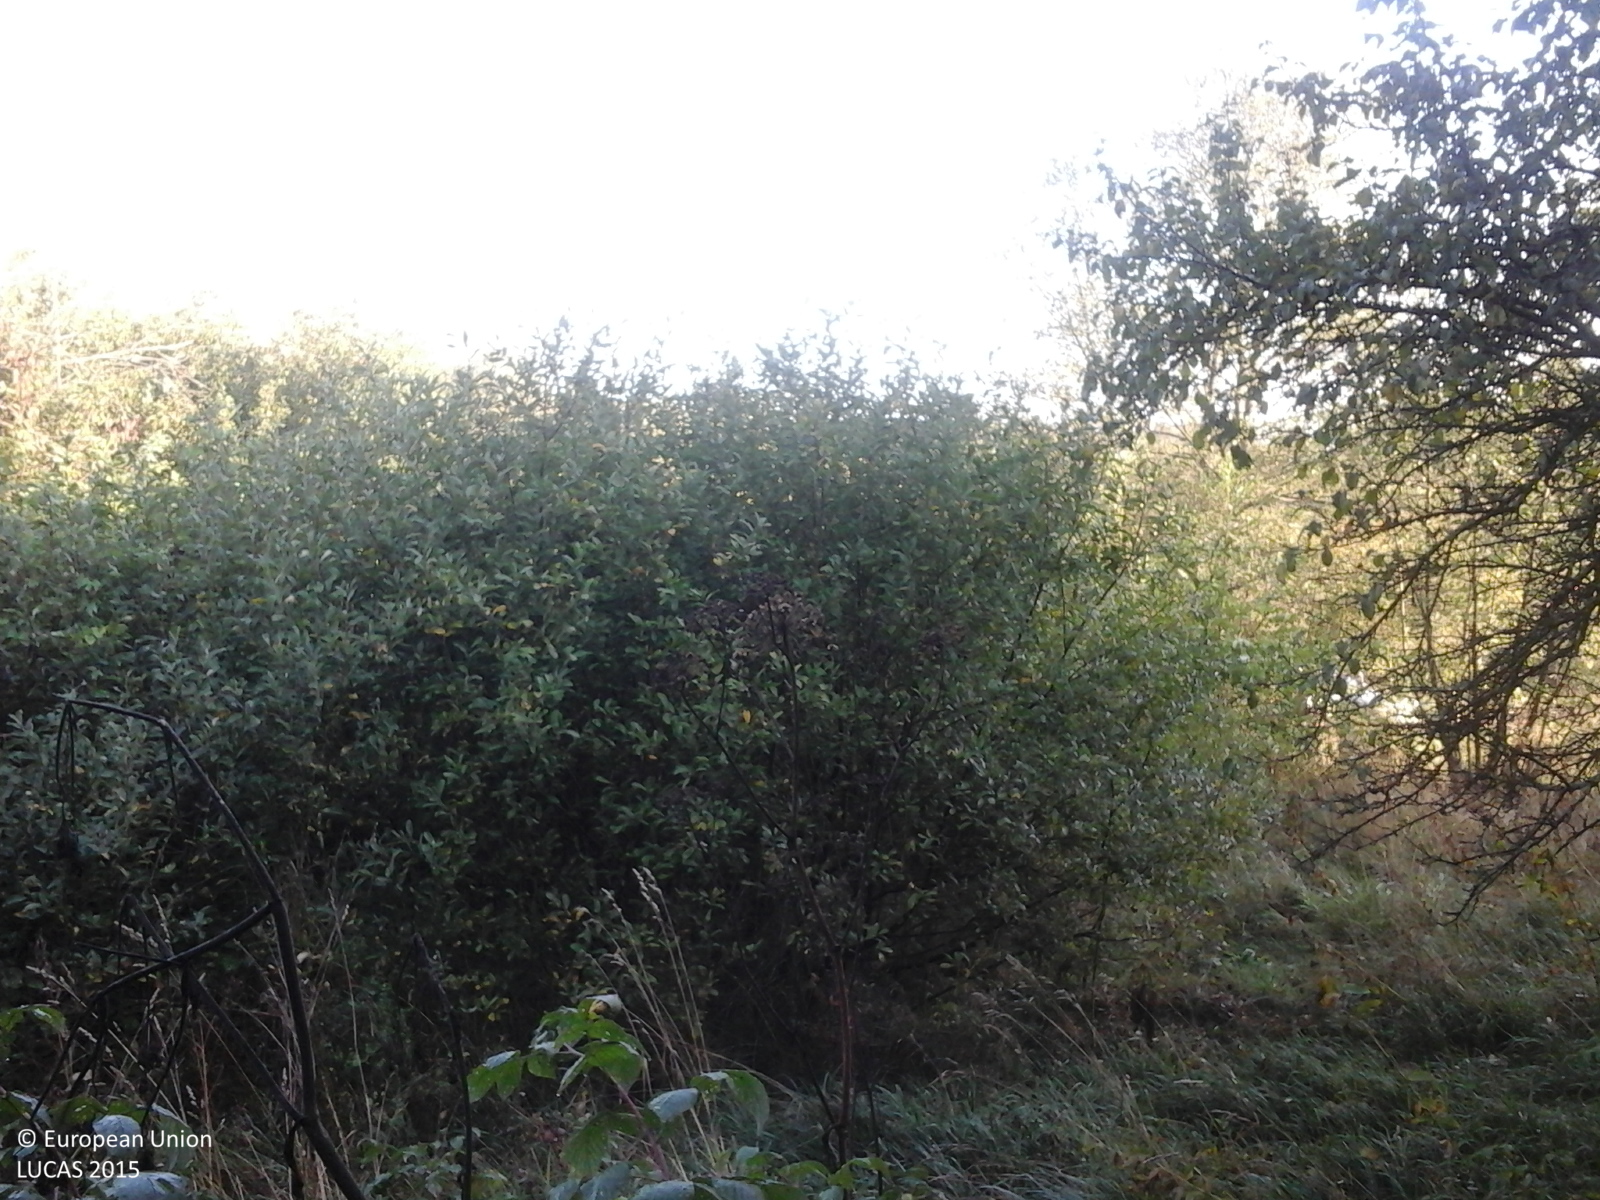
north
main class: Woodland
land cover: Broadleaved woodland
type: non-riverine alder, birch or aspen forest
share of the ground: > 75 %
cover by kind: broadleaved forest trees 100 %
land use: Forestry
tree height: > 5 m
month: September
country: RO
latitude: 45.1094
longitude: 22.3053
